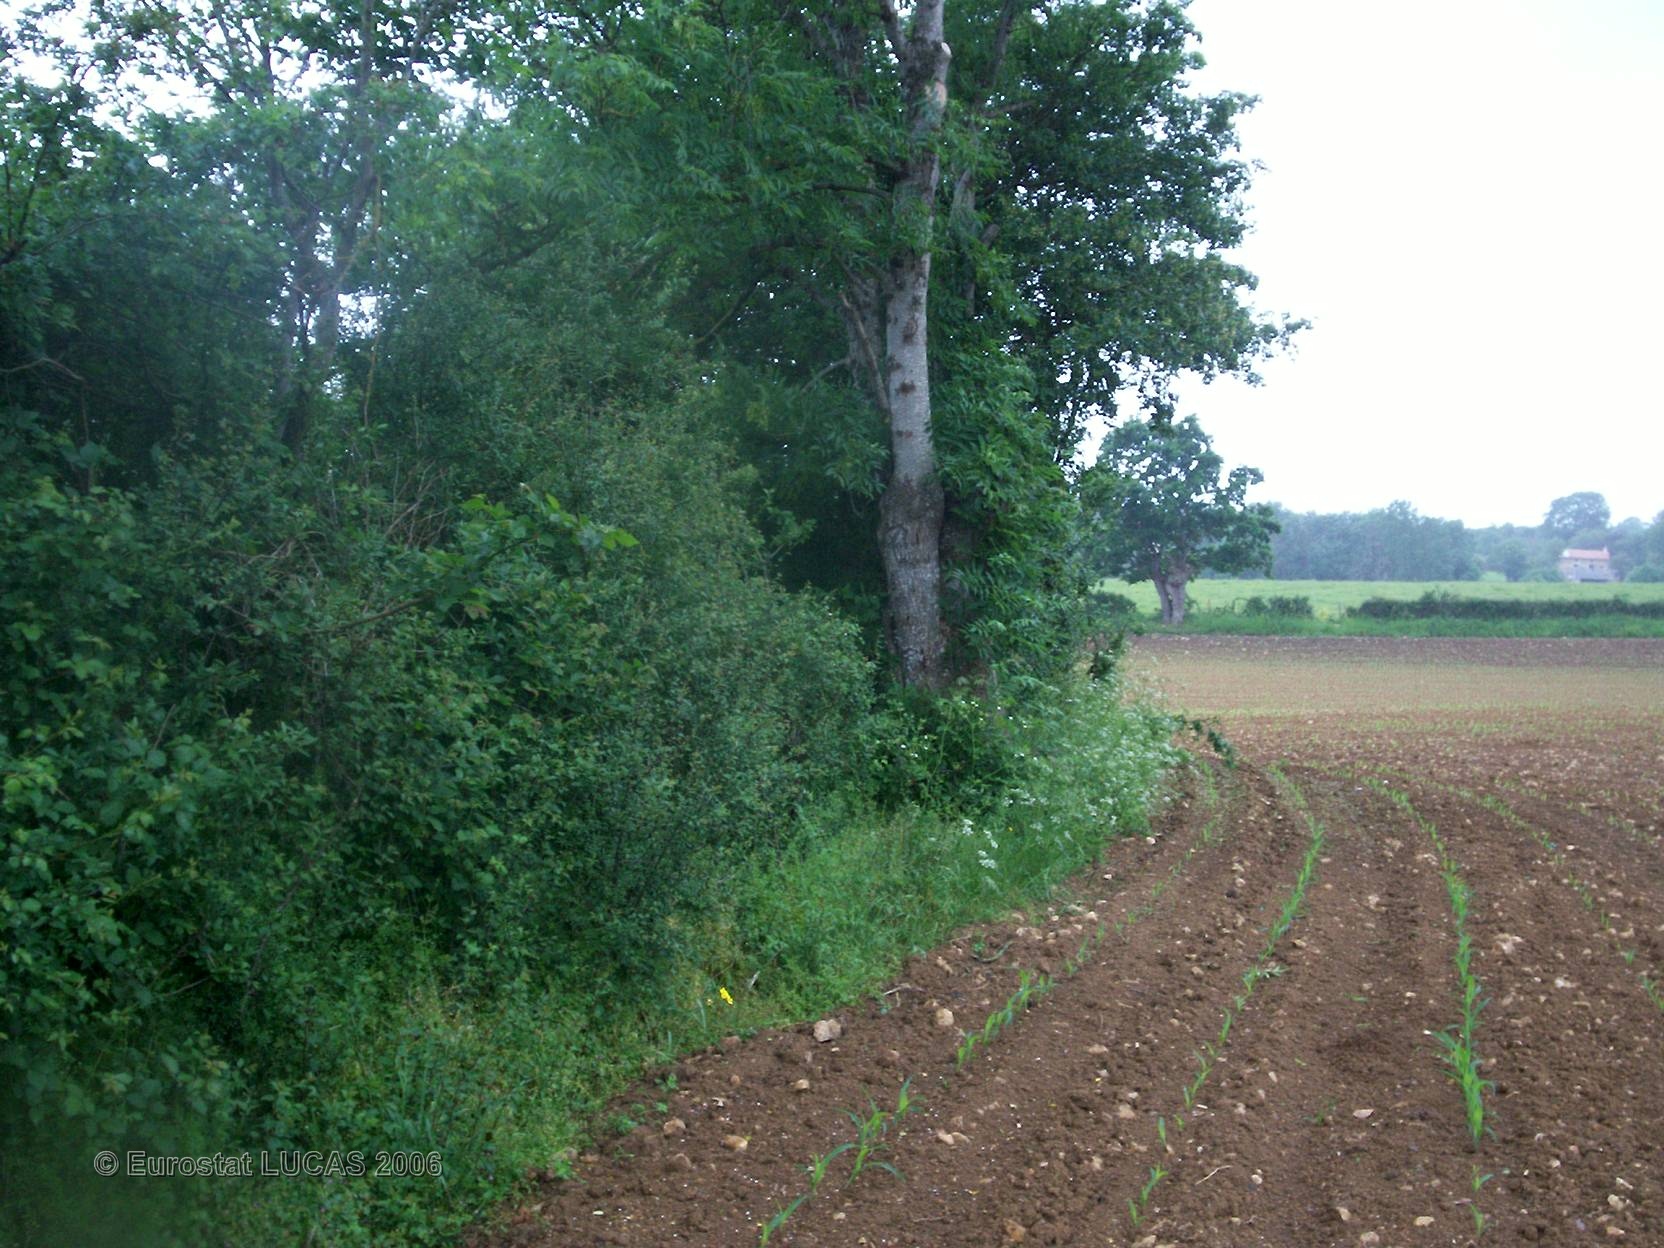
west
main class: Cropland
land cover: Maize
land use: Agriculture (excluding fallow land and kitchen gardens)
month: May
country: FR
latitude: 46.4748
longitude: -0.2479
